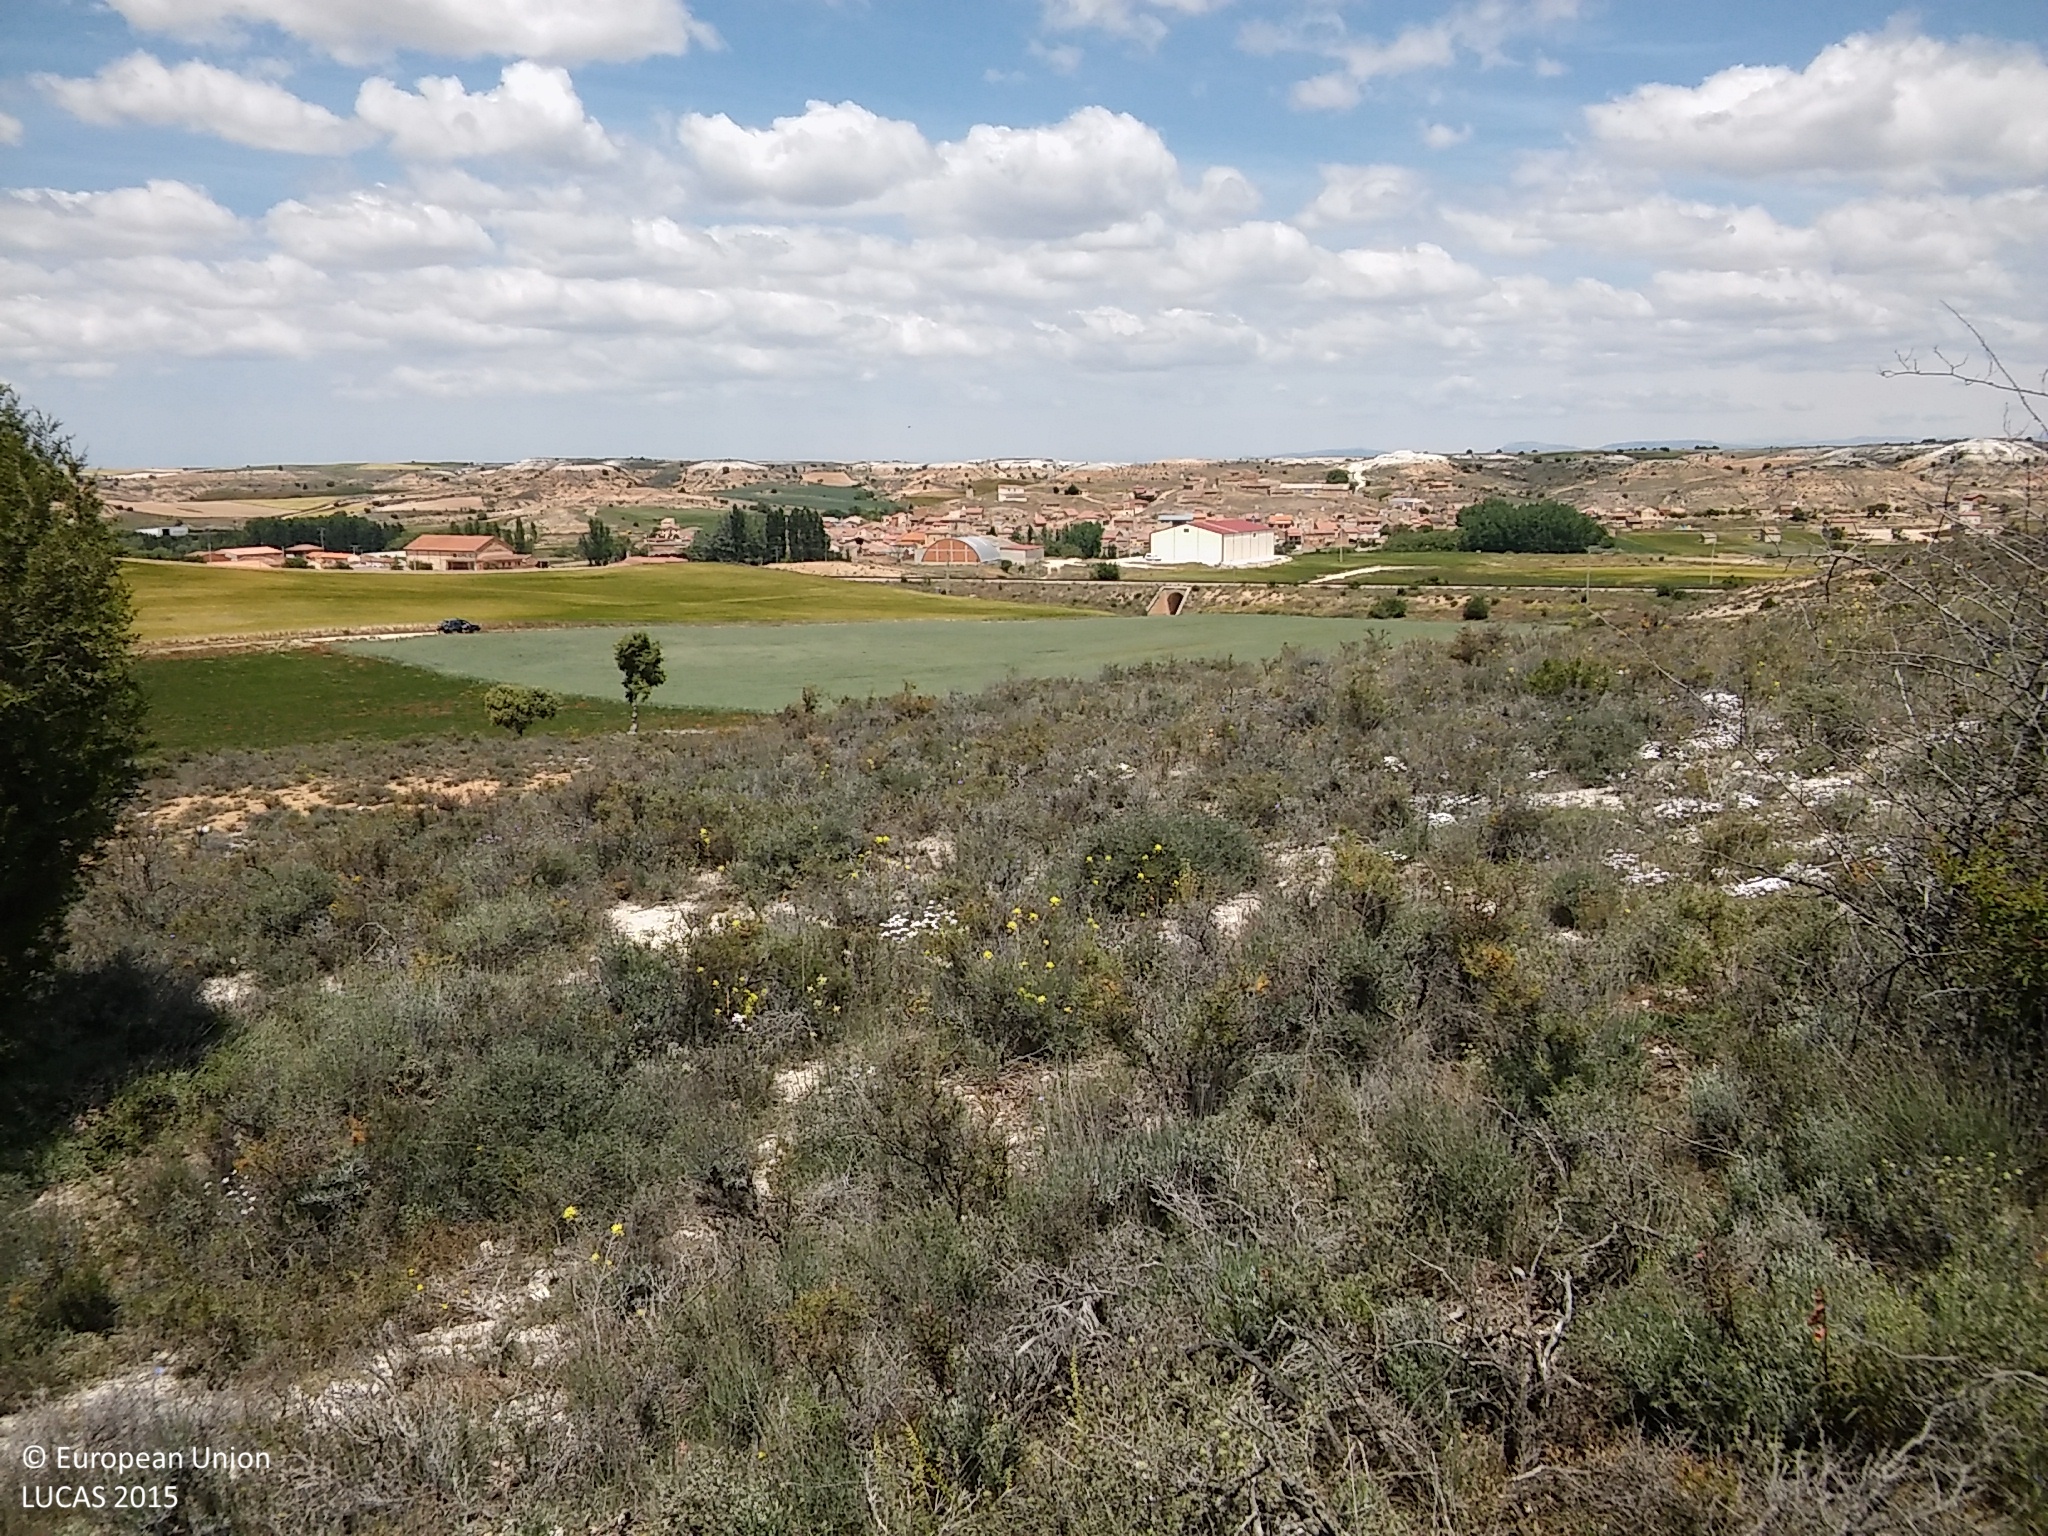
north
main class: Shrubland
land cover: Shrubland with sparse tree cover
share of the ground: > 75 %
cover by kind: shrubs 75 %, unconsolidated bare surface 20 %, coniferous forest trees 5 %
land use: Semi-natural and natural areas not in use
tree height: > 5 m
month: May
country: ES
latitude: 41.5865
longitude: -3.5933
